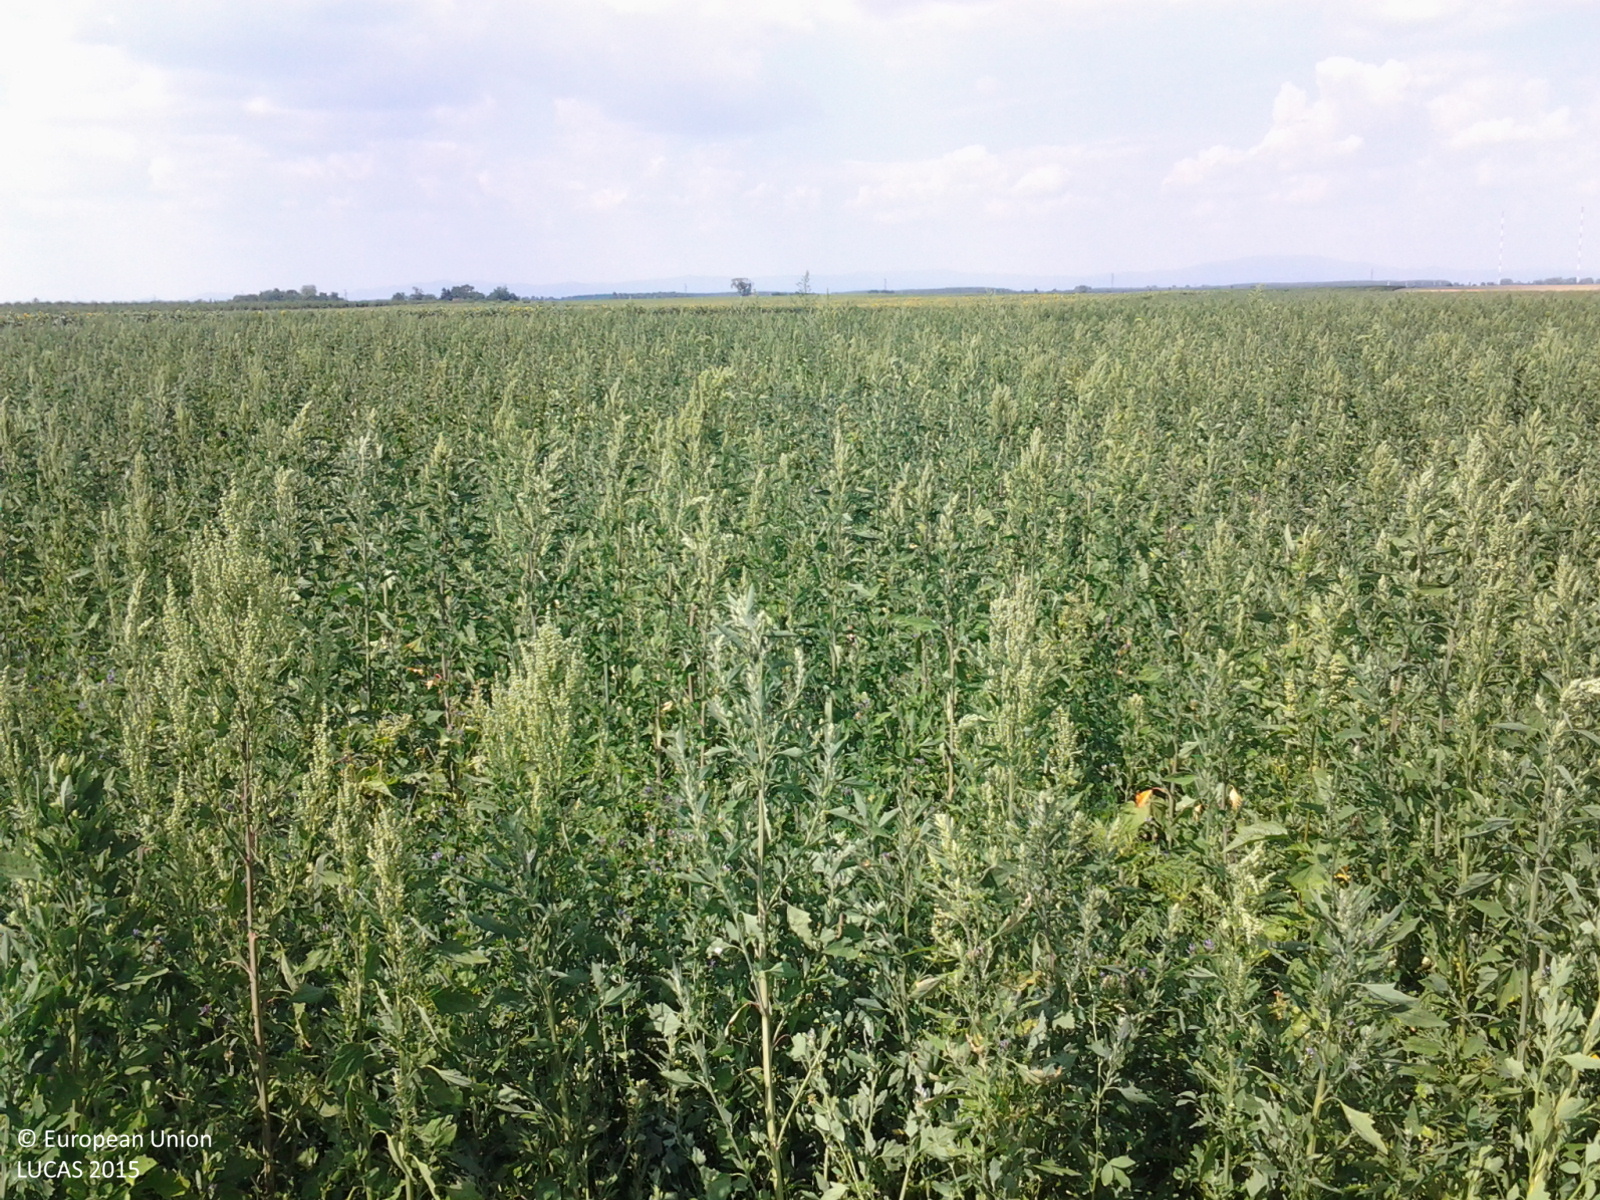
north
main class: Cropland
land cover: Lucerne
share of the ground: > 75 %
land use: Agriculture (excluding fallow land and kitchen gardens)
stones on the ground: < 10 %
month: July
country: HU
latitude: 47.5487
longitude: 19.8173
